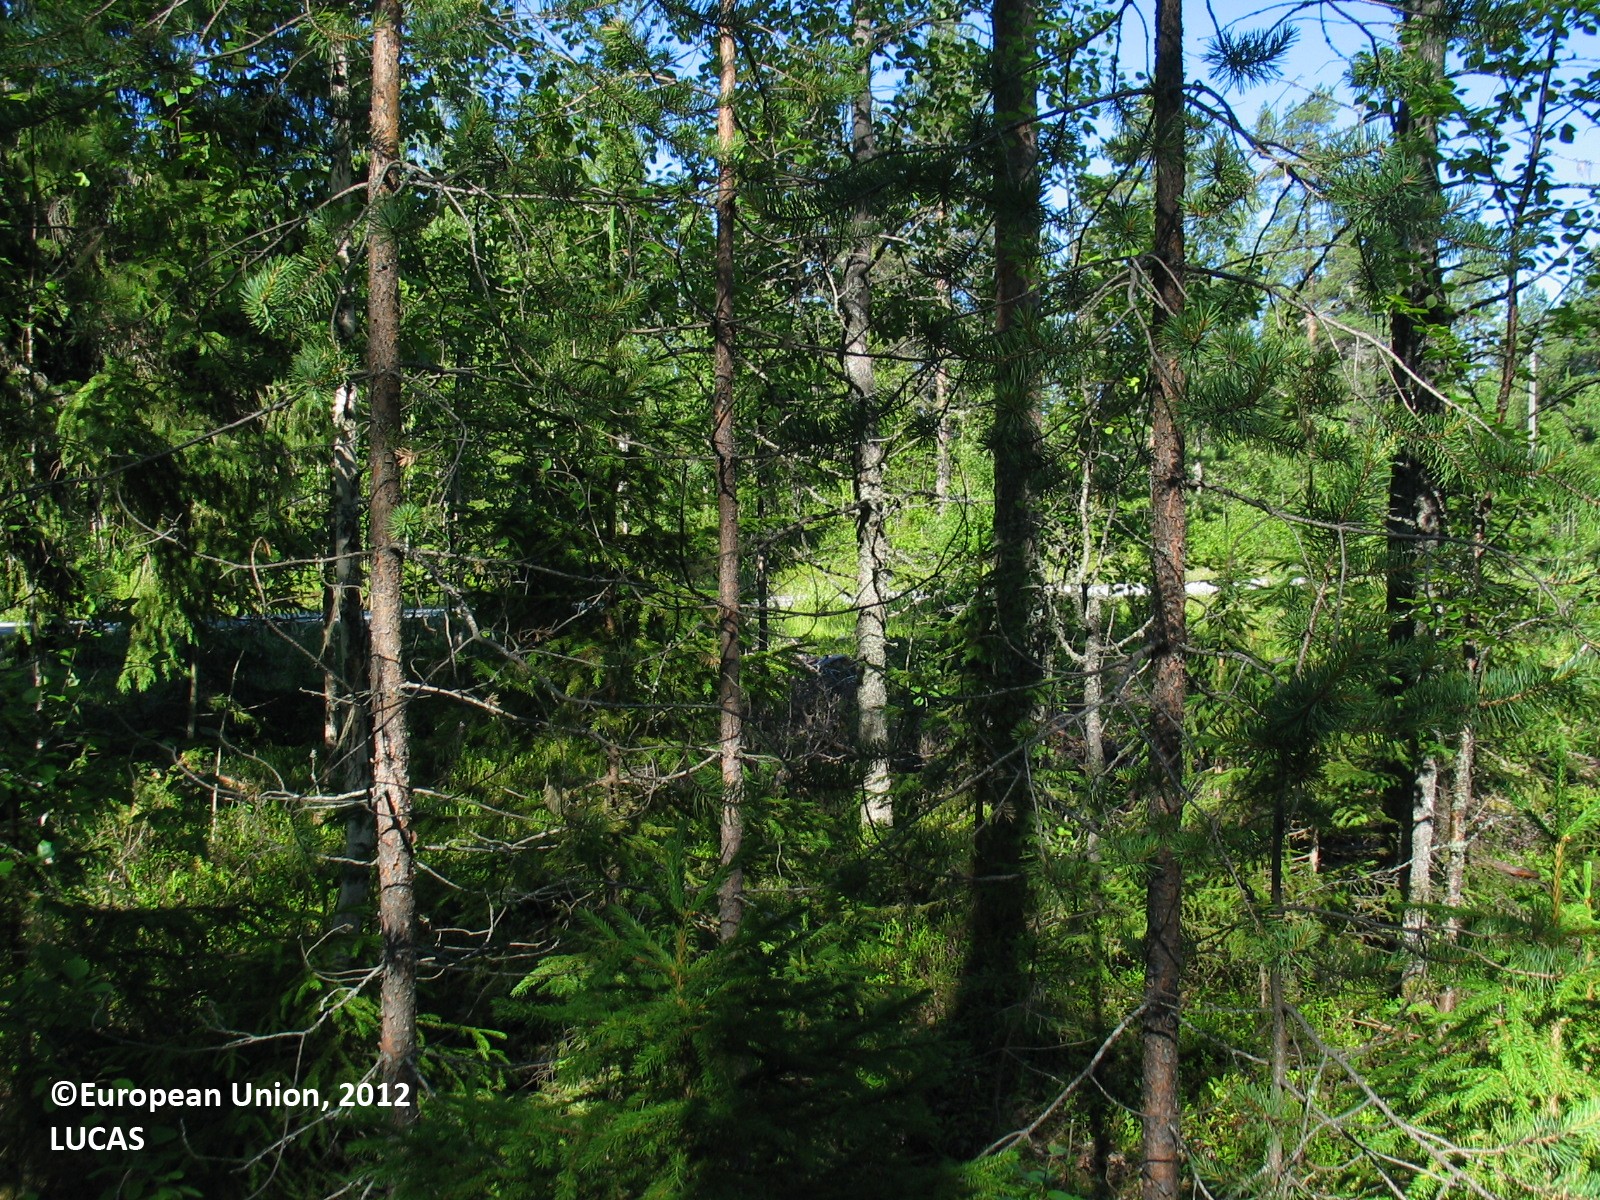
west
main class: Woodland
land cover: Other mixed woodland
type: boreal forest
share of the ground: 50 - 75 %
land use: Forestry
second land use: Sport
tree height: > 5 m
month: July
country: FI
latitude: 65.6598
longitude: 24.9589
